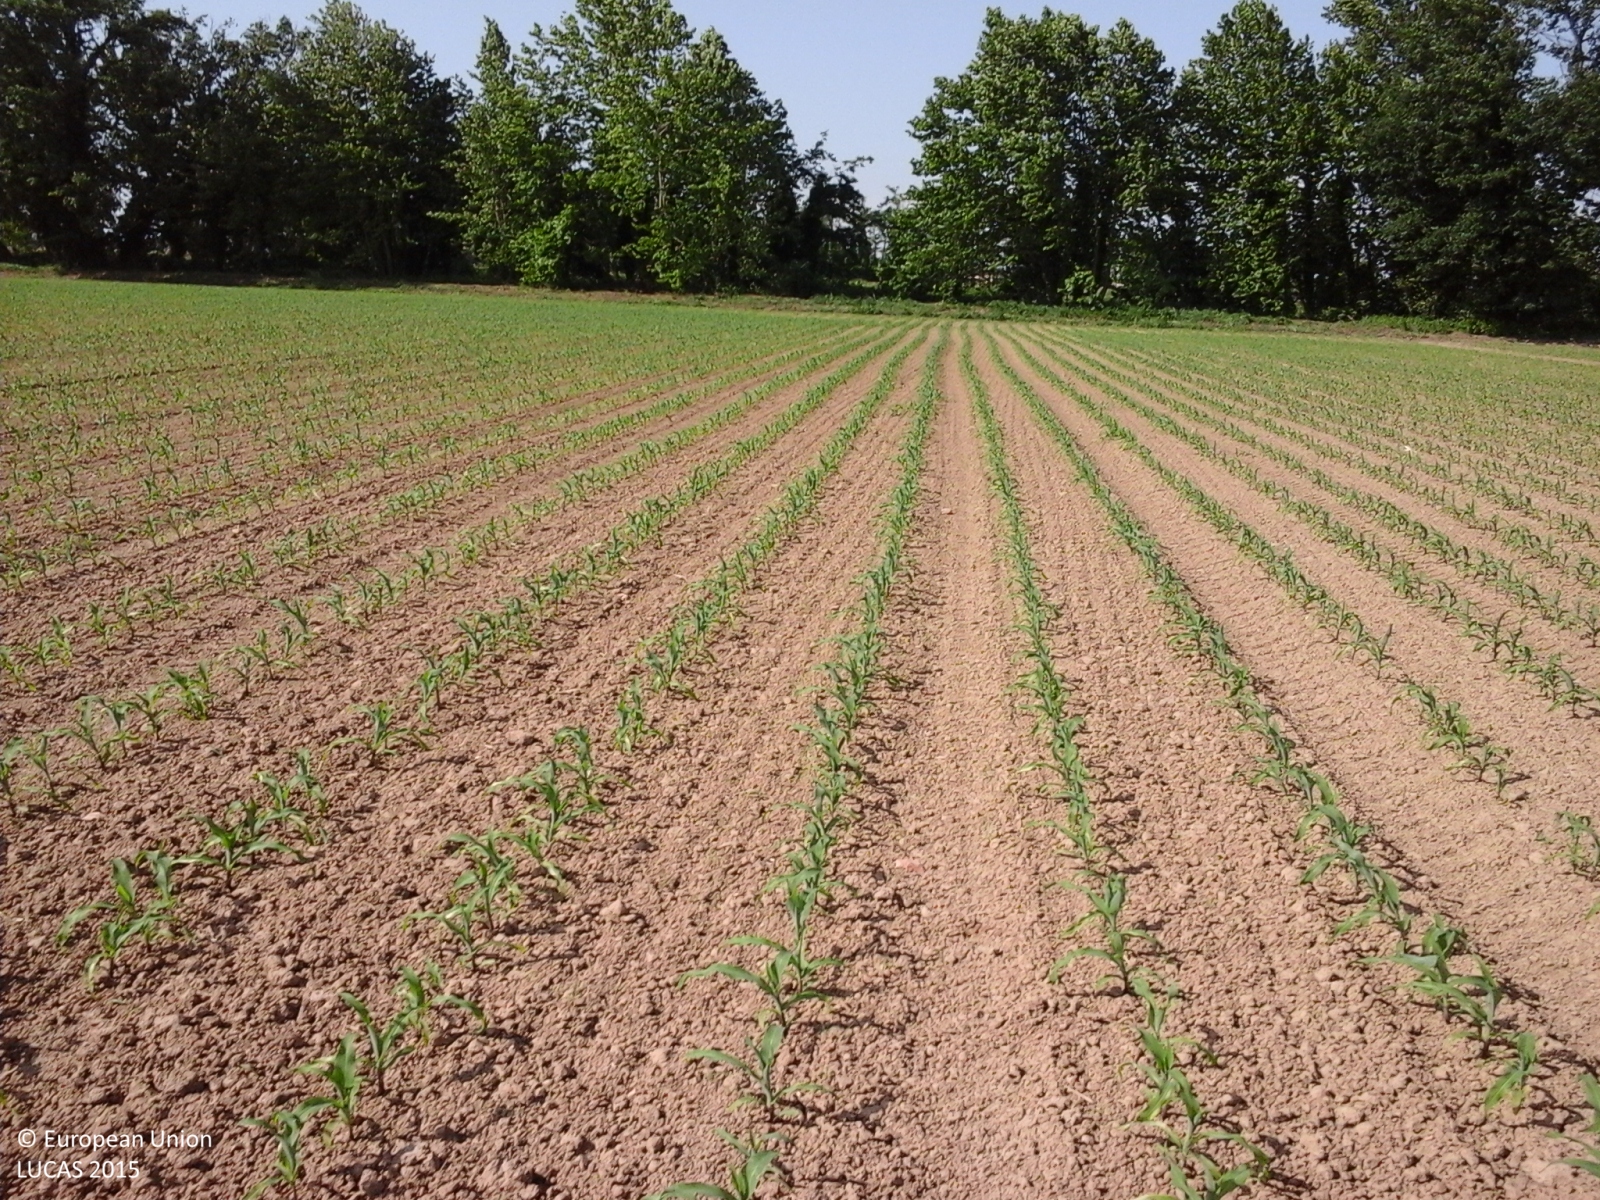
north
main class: Cropland
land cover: Maize
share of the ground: 10 - 25 %
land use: Agriculture (excluding fallow land and kitchen gardens)
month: May
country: IT
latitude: 45.1618
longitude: 10.1651
